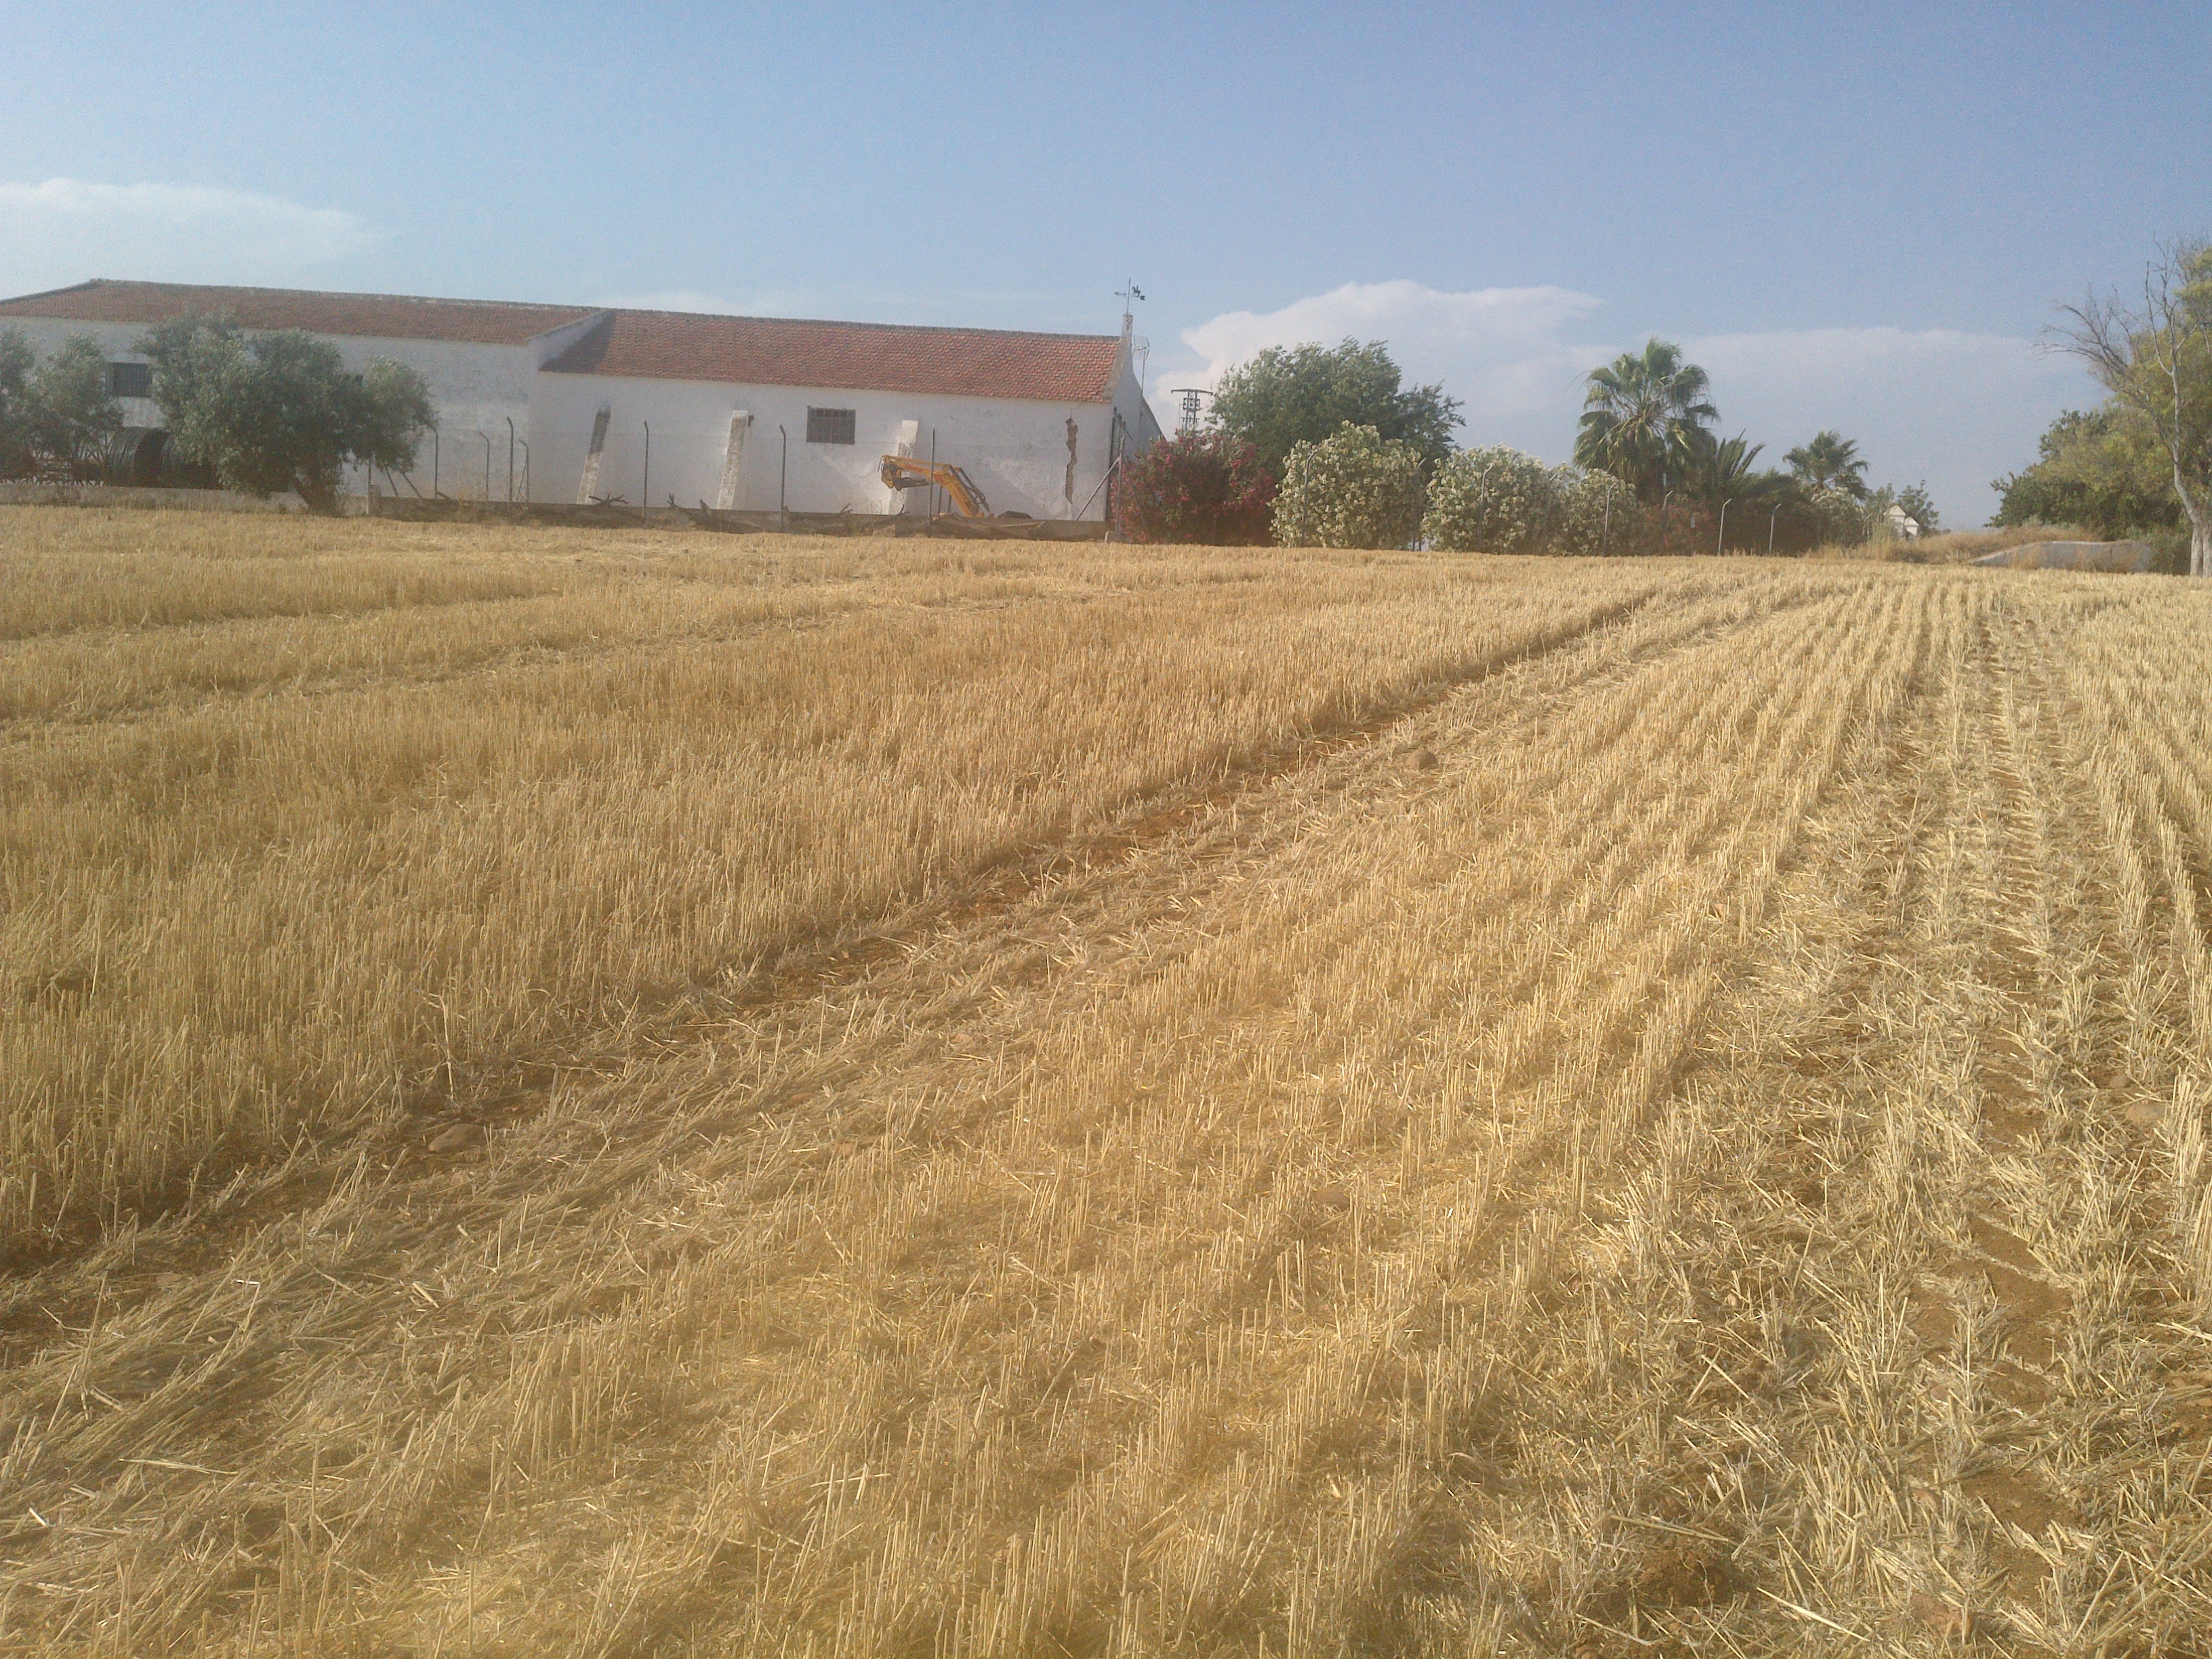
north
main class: Cropland
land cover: Durum wheat
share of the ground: < 10 %
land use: Agriculture (excluding fallow land and kitchen gardens)
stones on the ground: < 10 %
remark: Harvested field
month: June
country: ES
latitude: 37.7454
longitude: -4.8918
